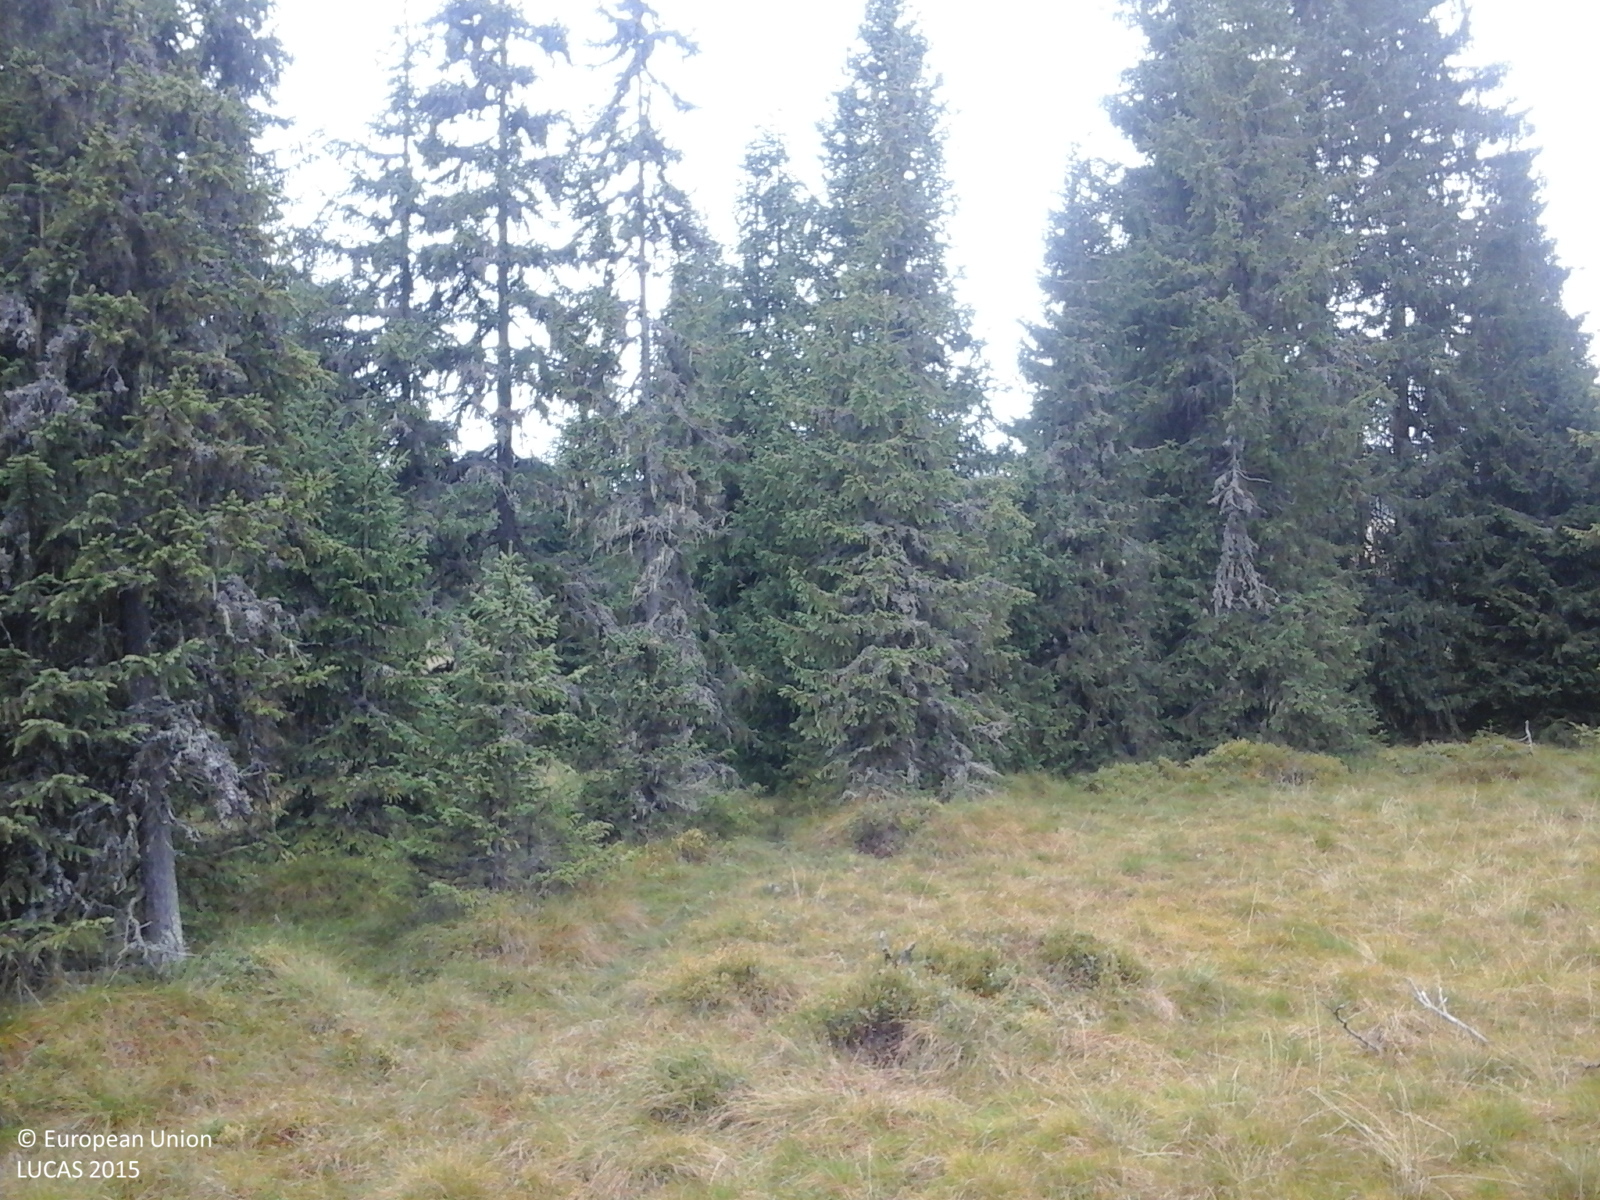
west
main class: Woodland
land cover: Spruce dominated coniferous woodland
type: alpine coniferous forest
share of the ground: > 75 %
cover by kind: coniferous forest trees 100 %
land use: Forestry
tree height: > 5 m
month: October
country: RO
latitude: 46.5185
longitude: 23.1619
